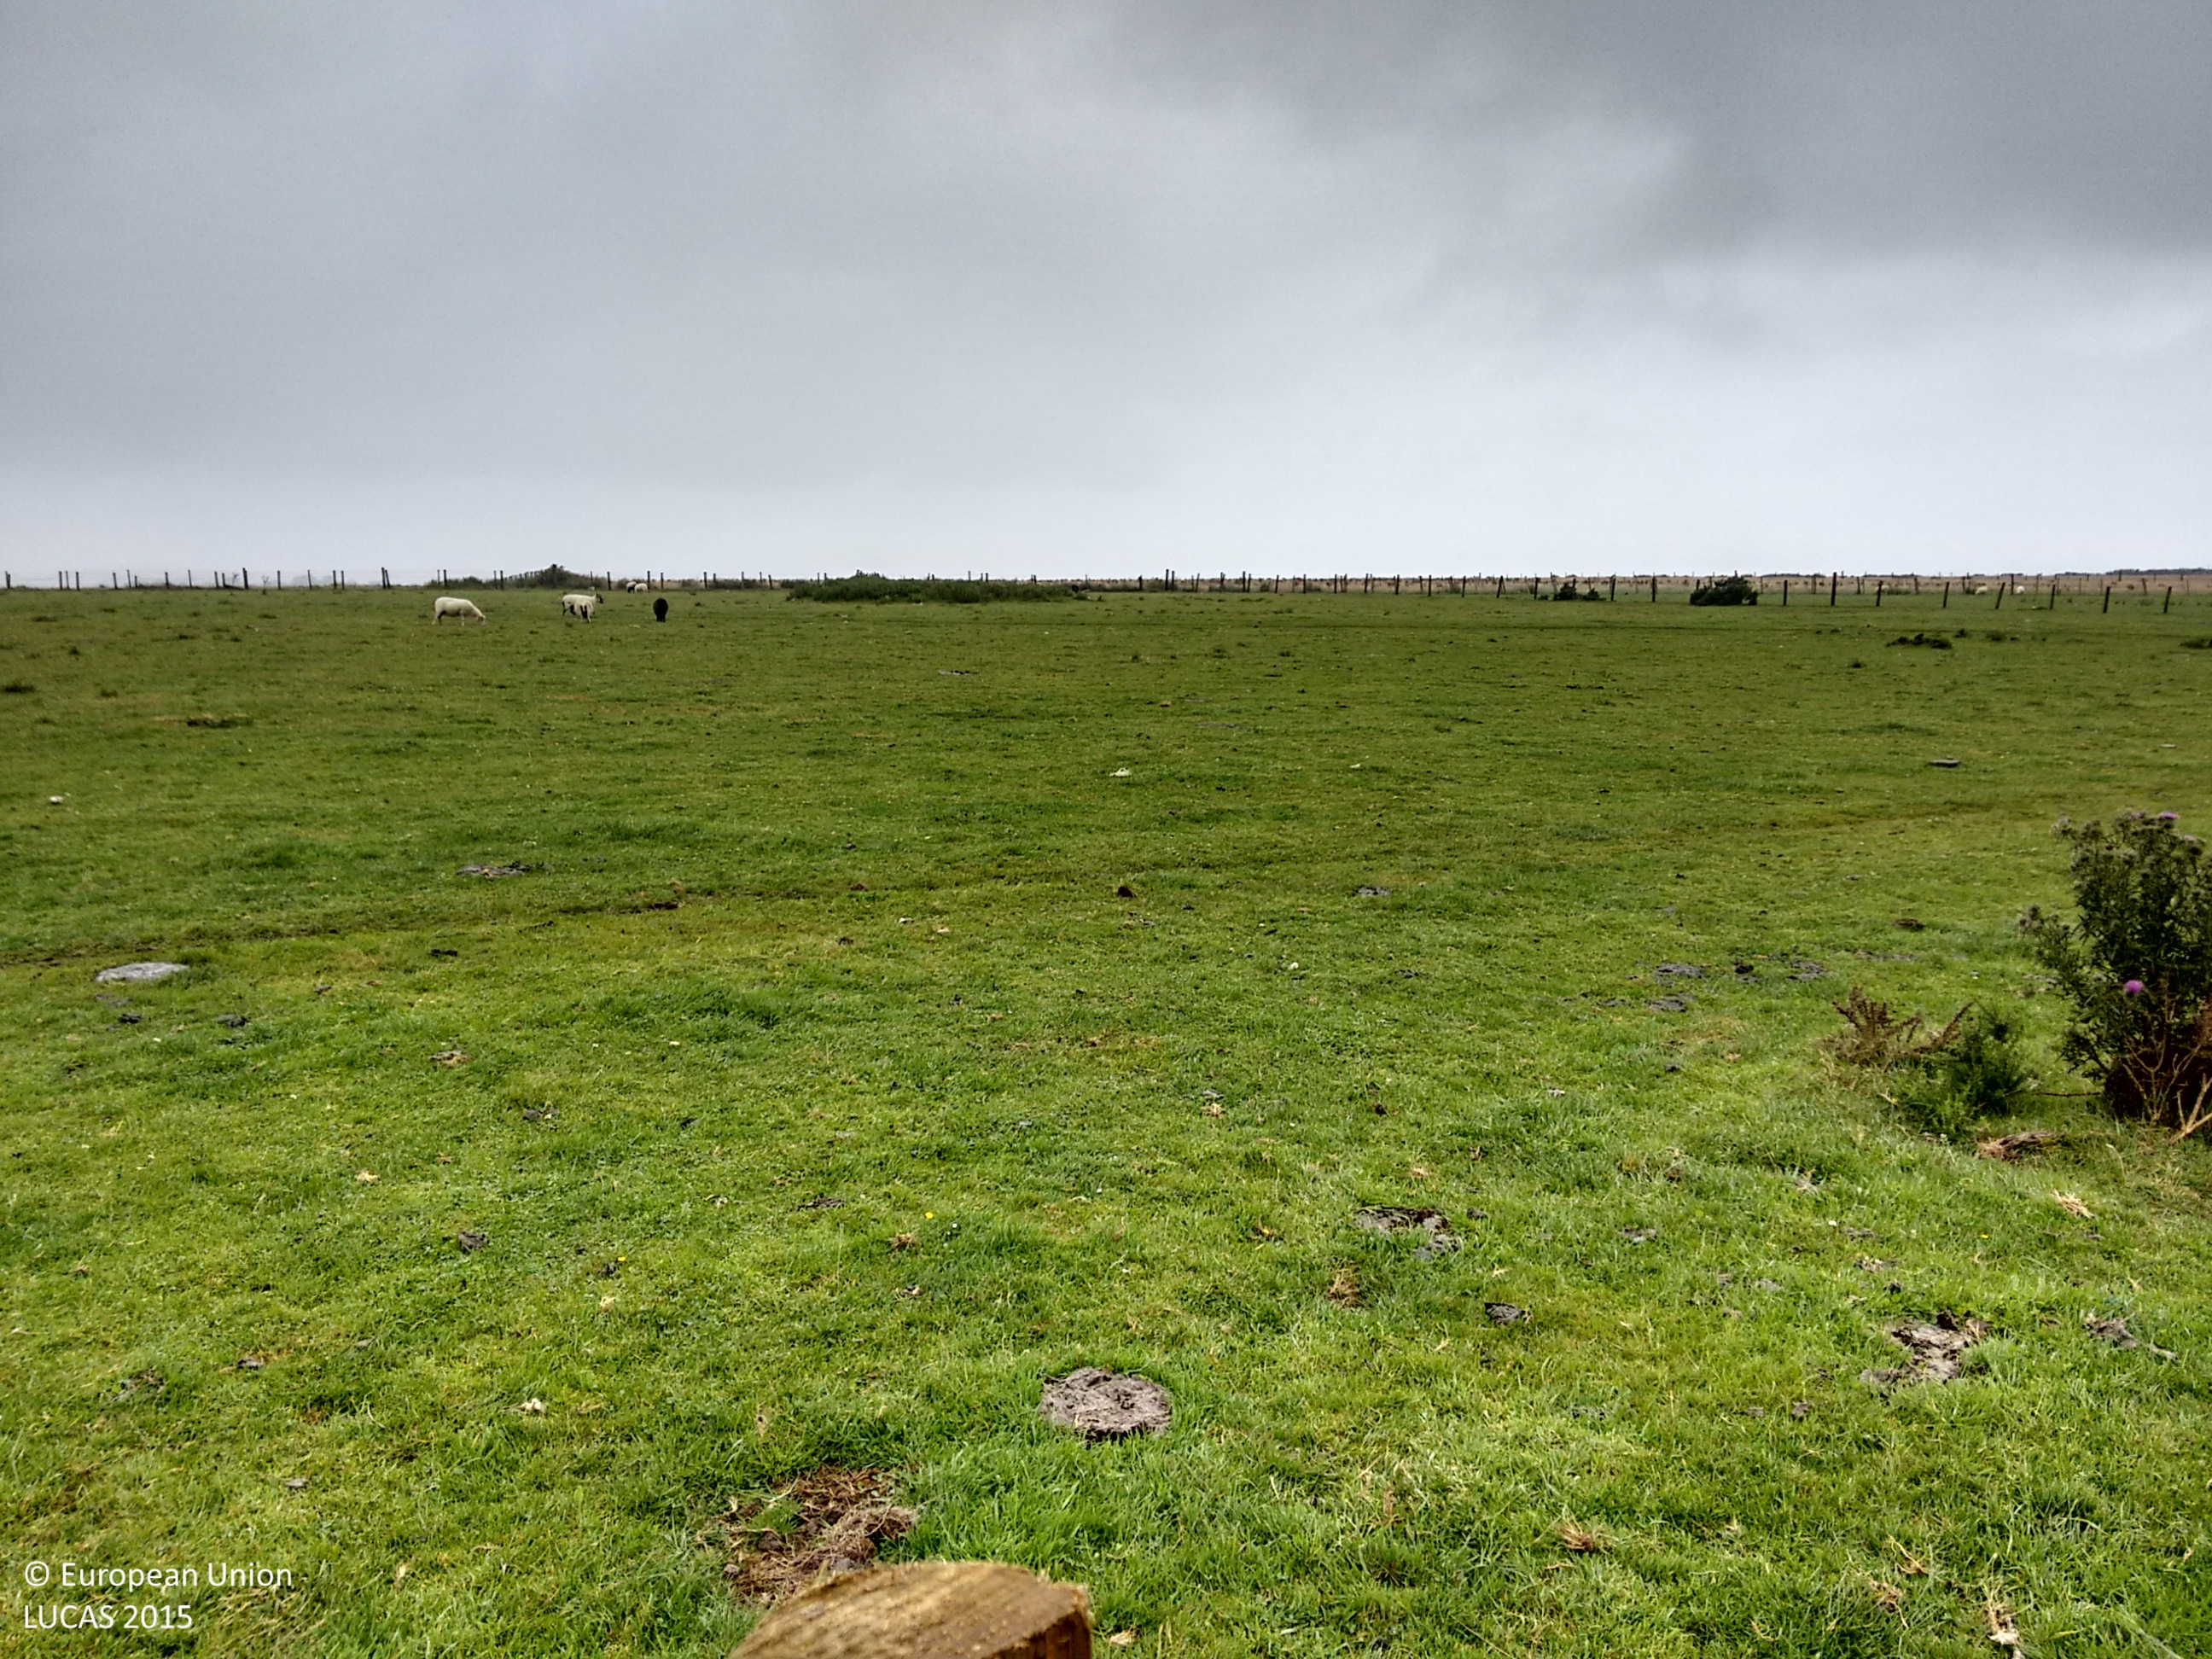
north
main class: Grassland
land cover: Grassland without tree/shrub cover
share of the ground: > 75 %
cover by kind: herbaceous plants 100 %
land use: Agriculture (excluding fallow land and kitchen gardens)
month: August
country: GB
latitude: 51.9528
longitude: -4.5256
